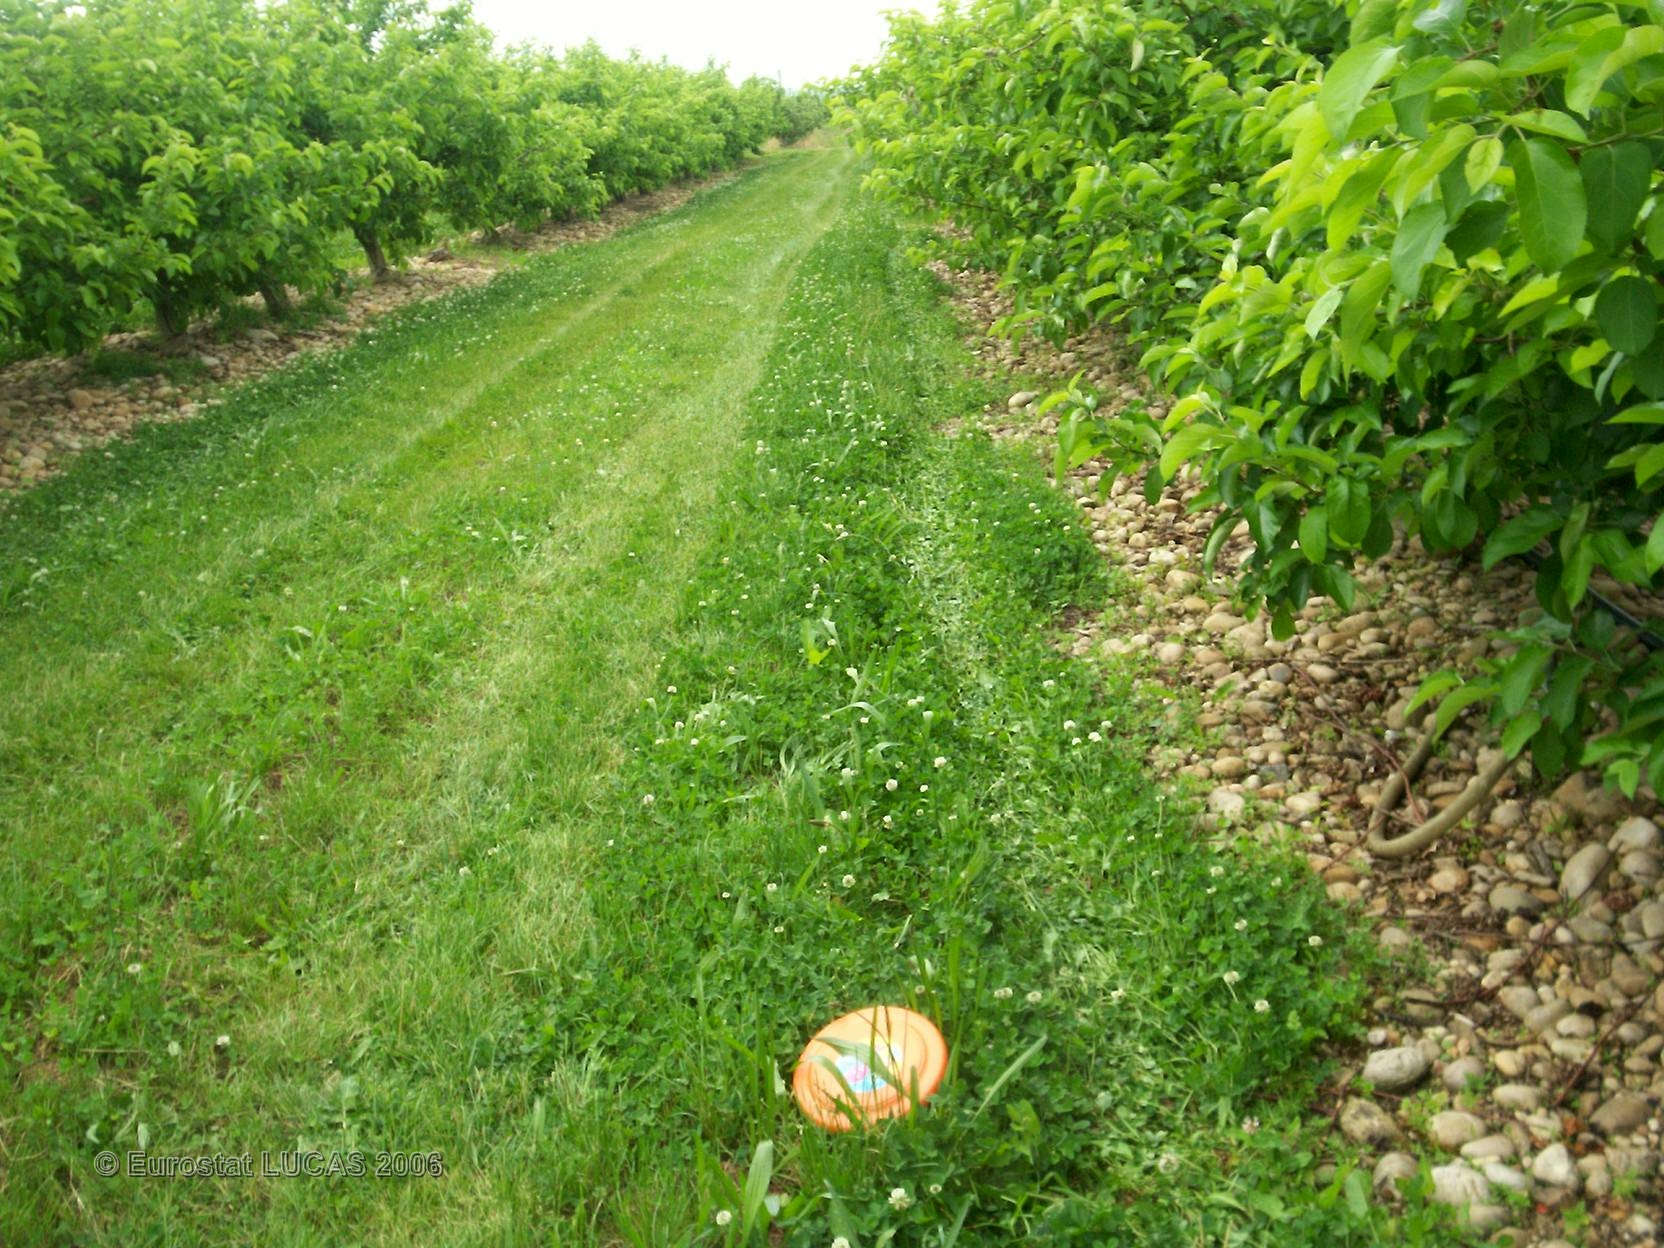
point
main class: Cropland
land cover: Pear fruit
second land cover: Grassland with sparse tree/shrub cover
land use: Agriculture (excluding fallow land and kitchen gardens)
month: May
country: FR
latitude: 45.6450
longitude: 4.7560
